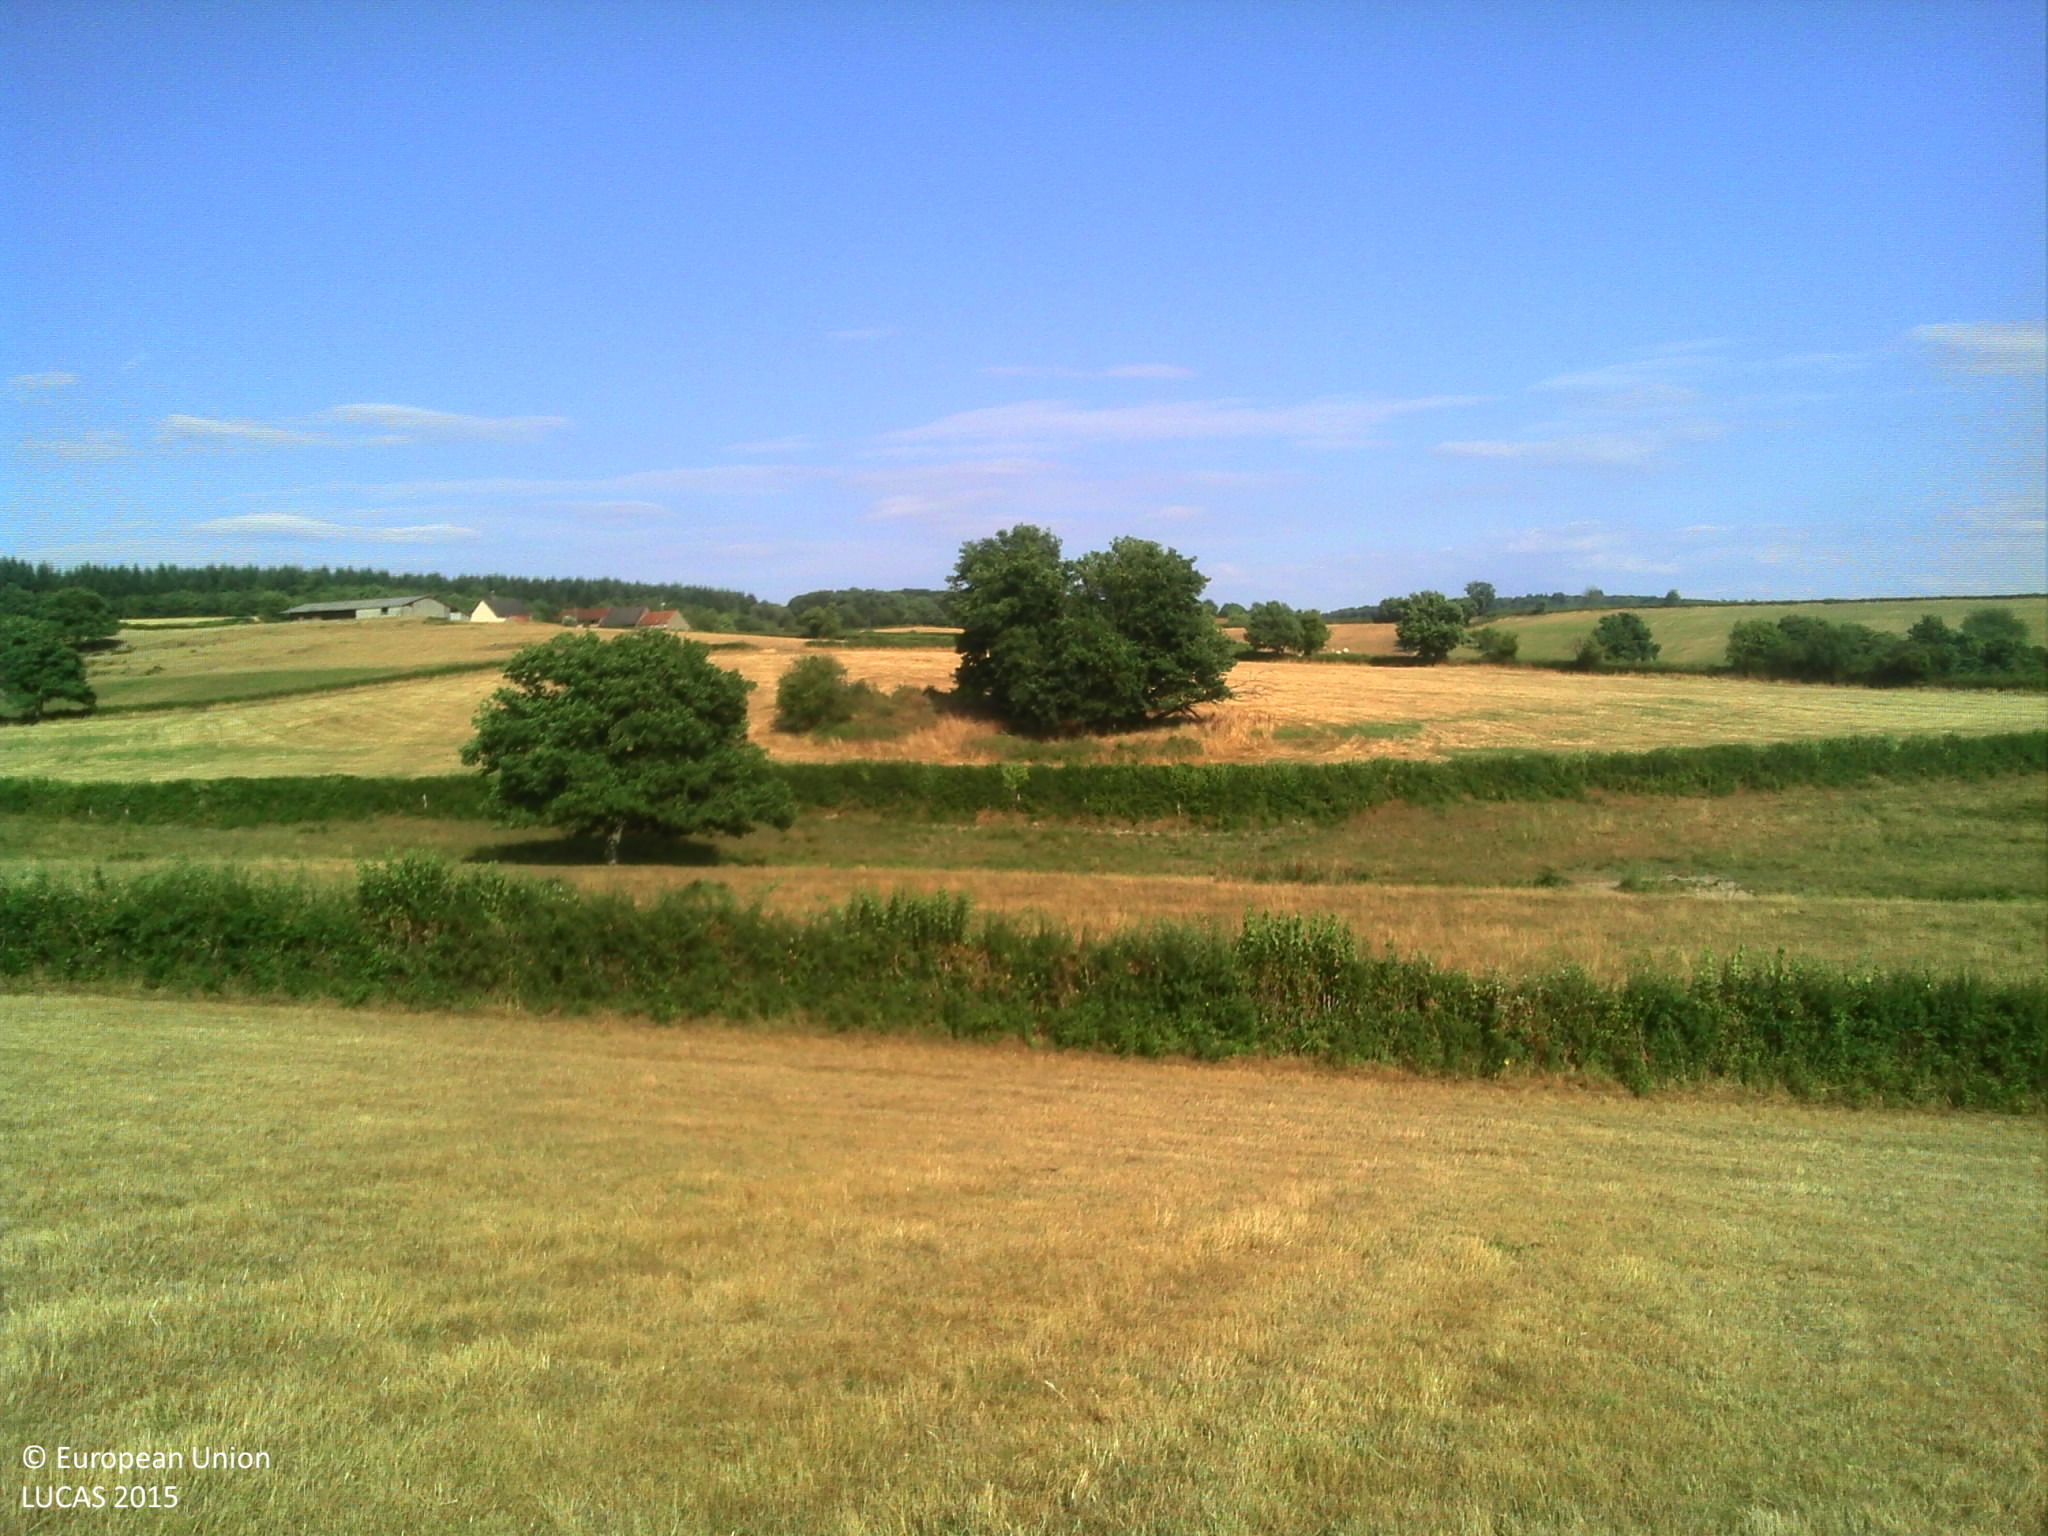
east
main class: Grassland
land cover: Grassland without tree/shrub cover
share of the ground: > 75 %
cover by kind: herbaceous plants 100 %
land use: Agriculture (excluding fallow land and kitchen gardens)
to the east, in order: Grassland without tree/shrub cover; Managed hedges; Fences; Grassland without tree/shrub cover; Single bushes/trees; Rivers and streams; Grassland without tree/shrub cover; Managed hedges; Fences; Grassland without tree/shrub cover
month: July
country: FR
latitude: 46.6183
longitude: 4.3725
